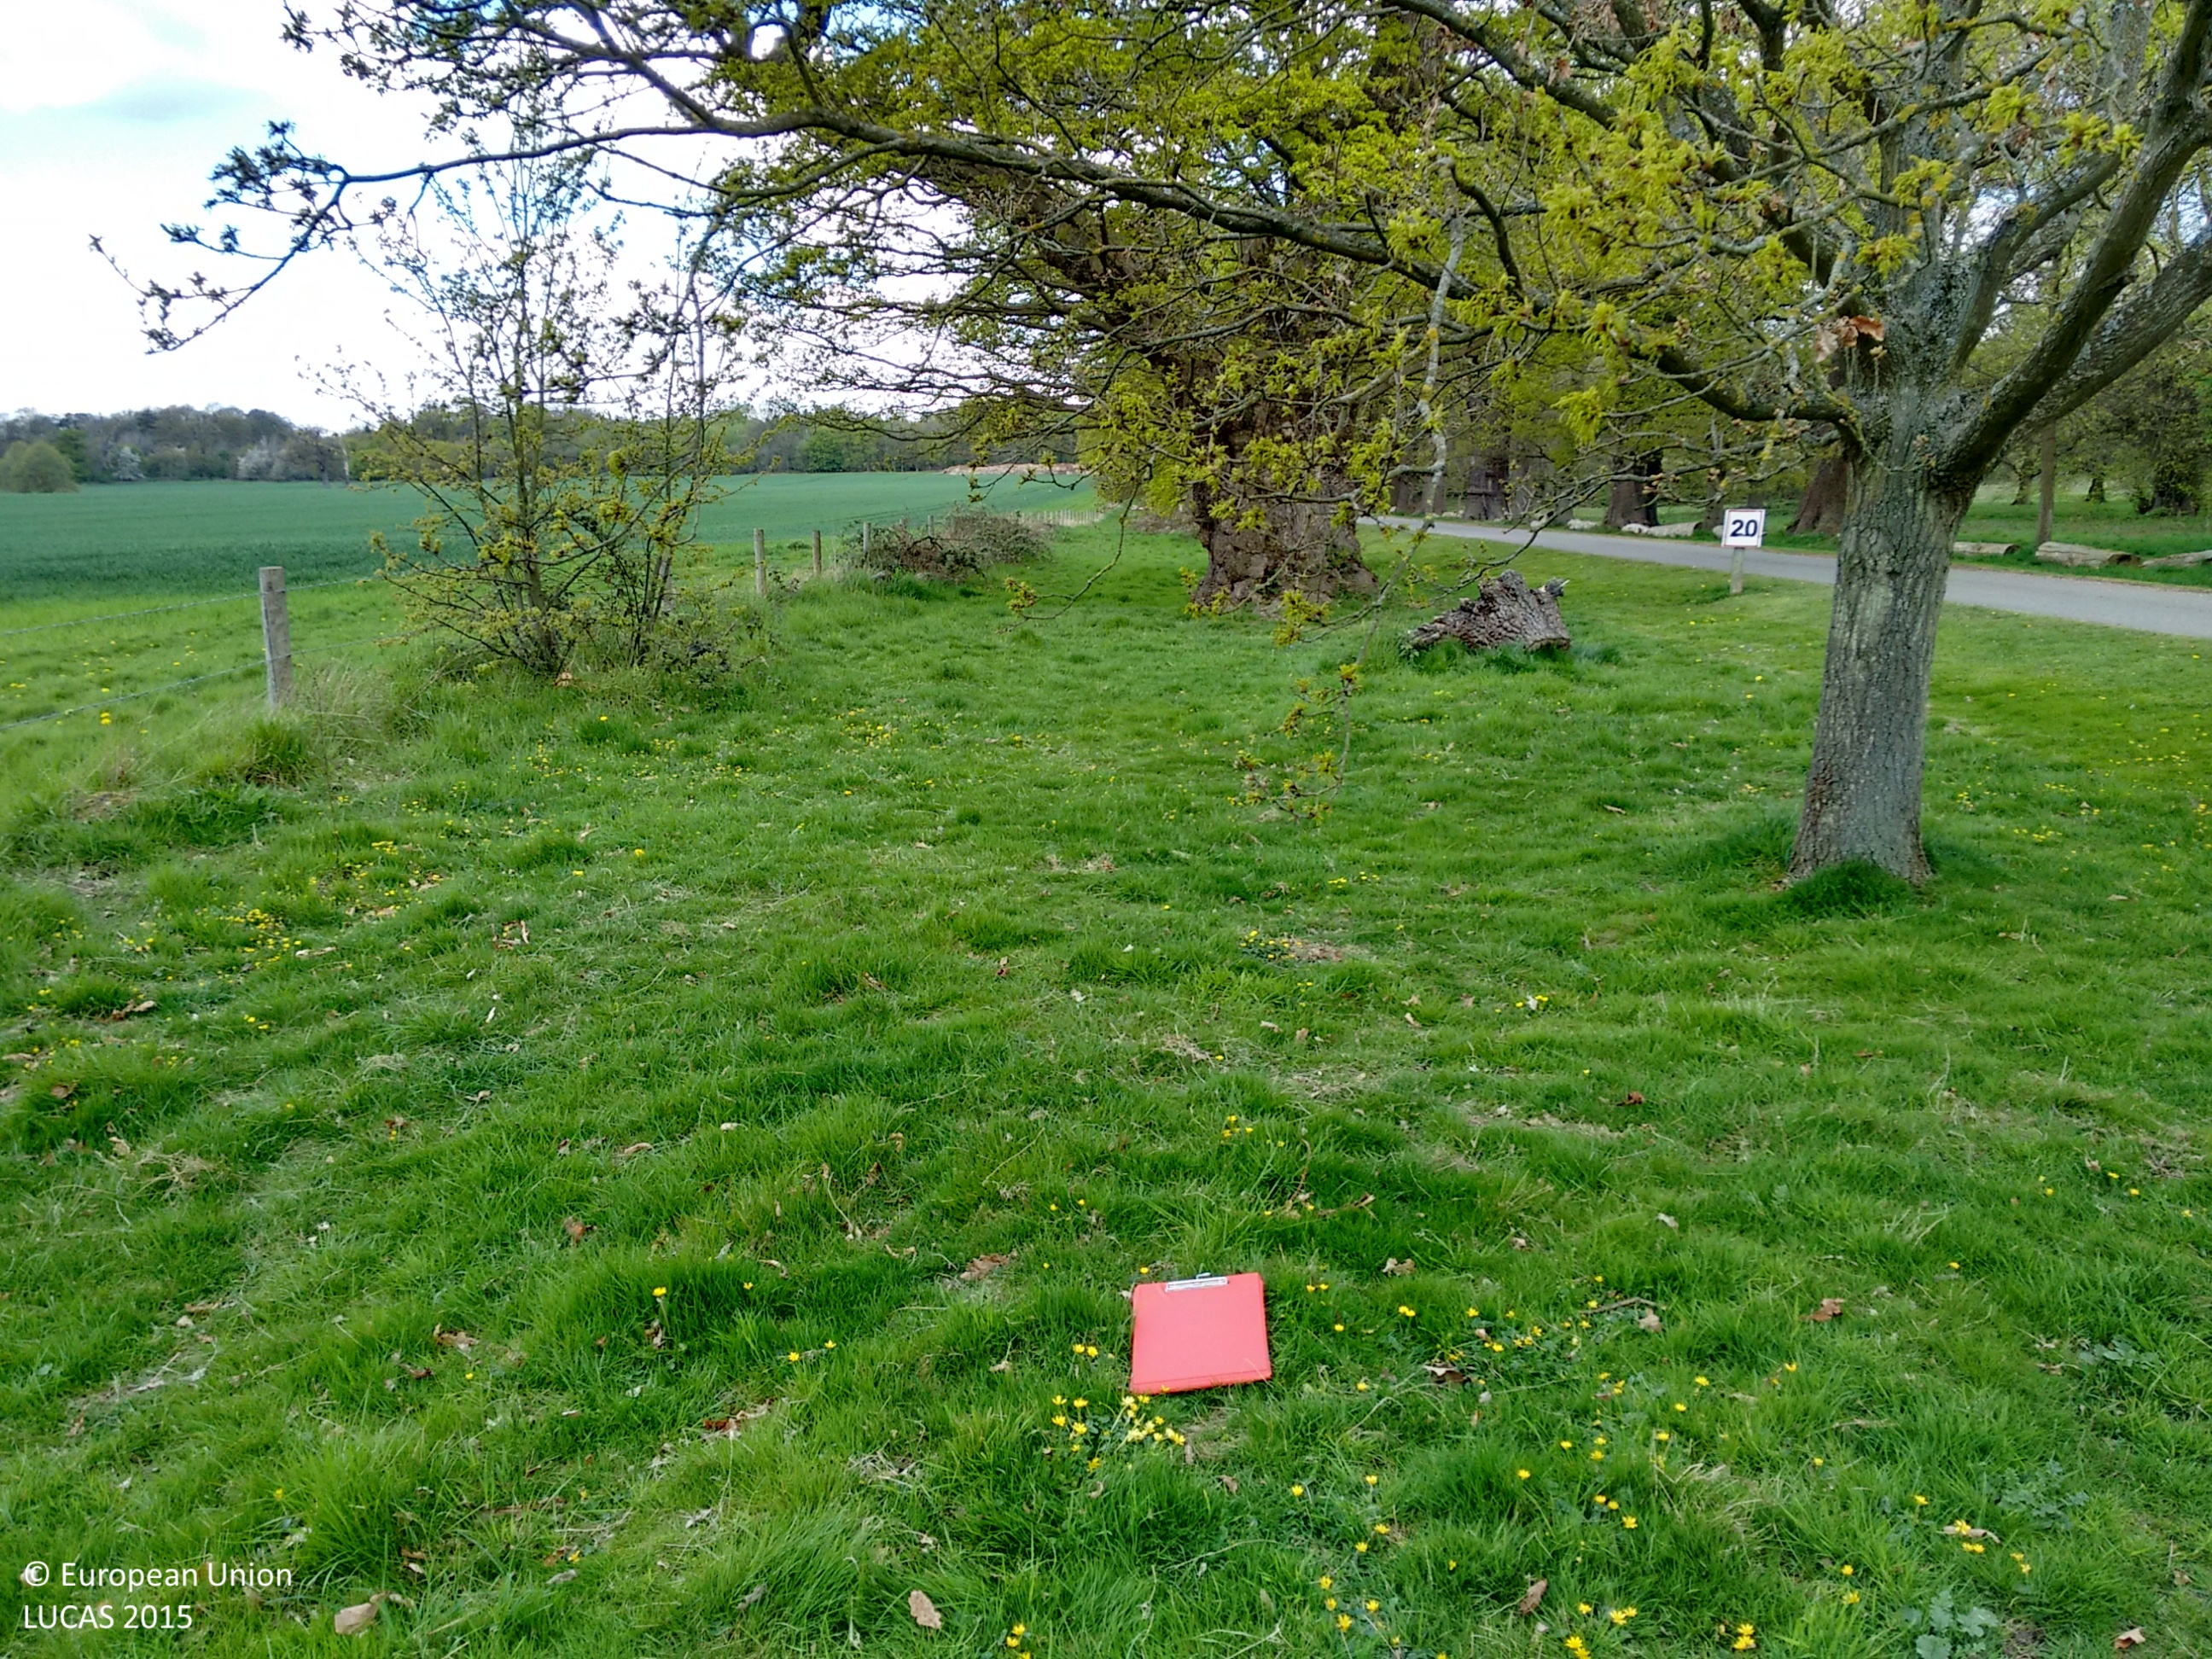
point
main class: Woodland
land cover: Broadleaved woodland
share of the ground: 50 - 75 %
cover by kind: broadleaved forest trees 50 %, herbaceous plants 50 %
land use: Residential
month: April
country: GB
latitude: 51.5255
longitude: -0.5464
